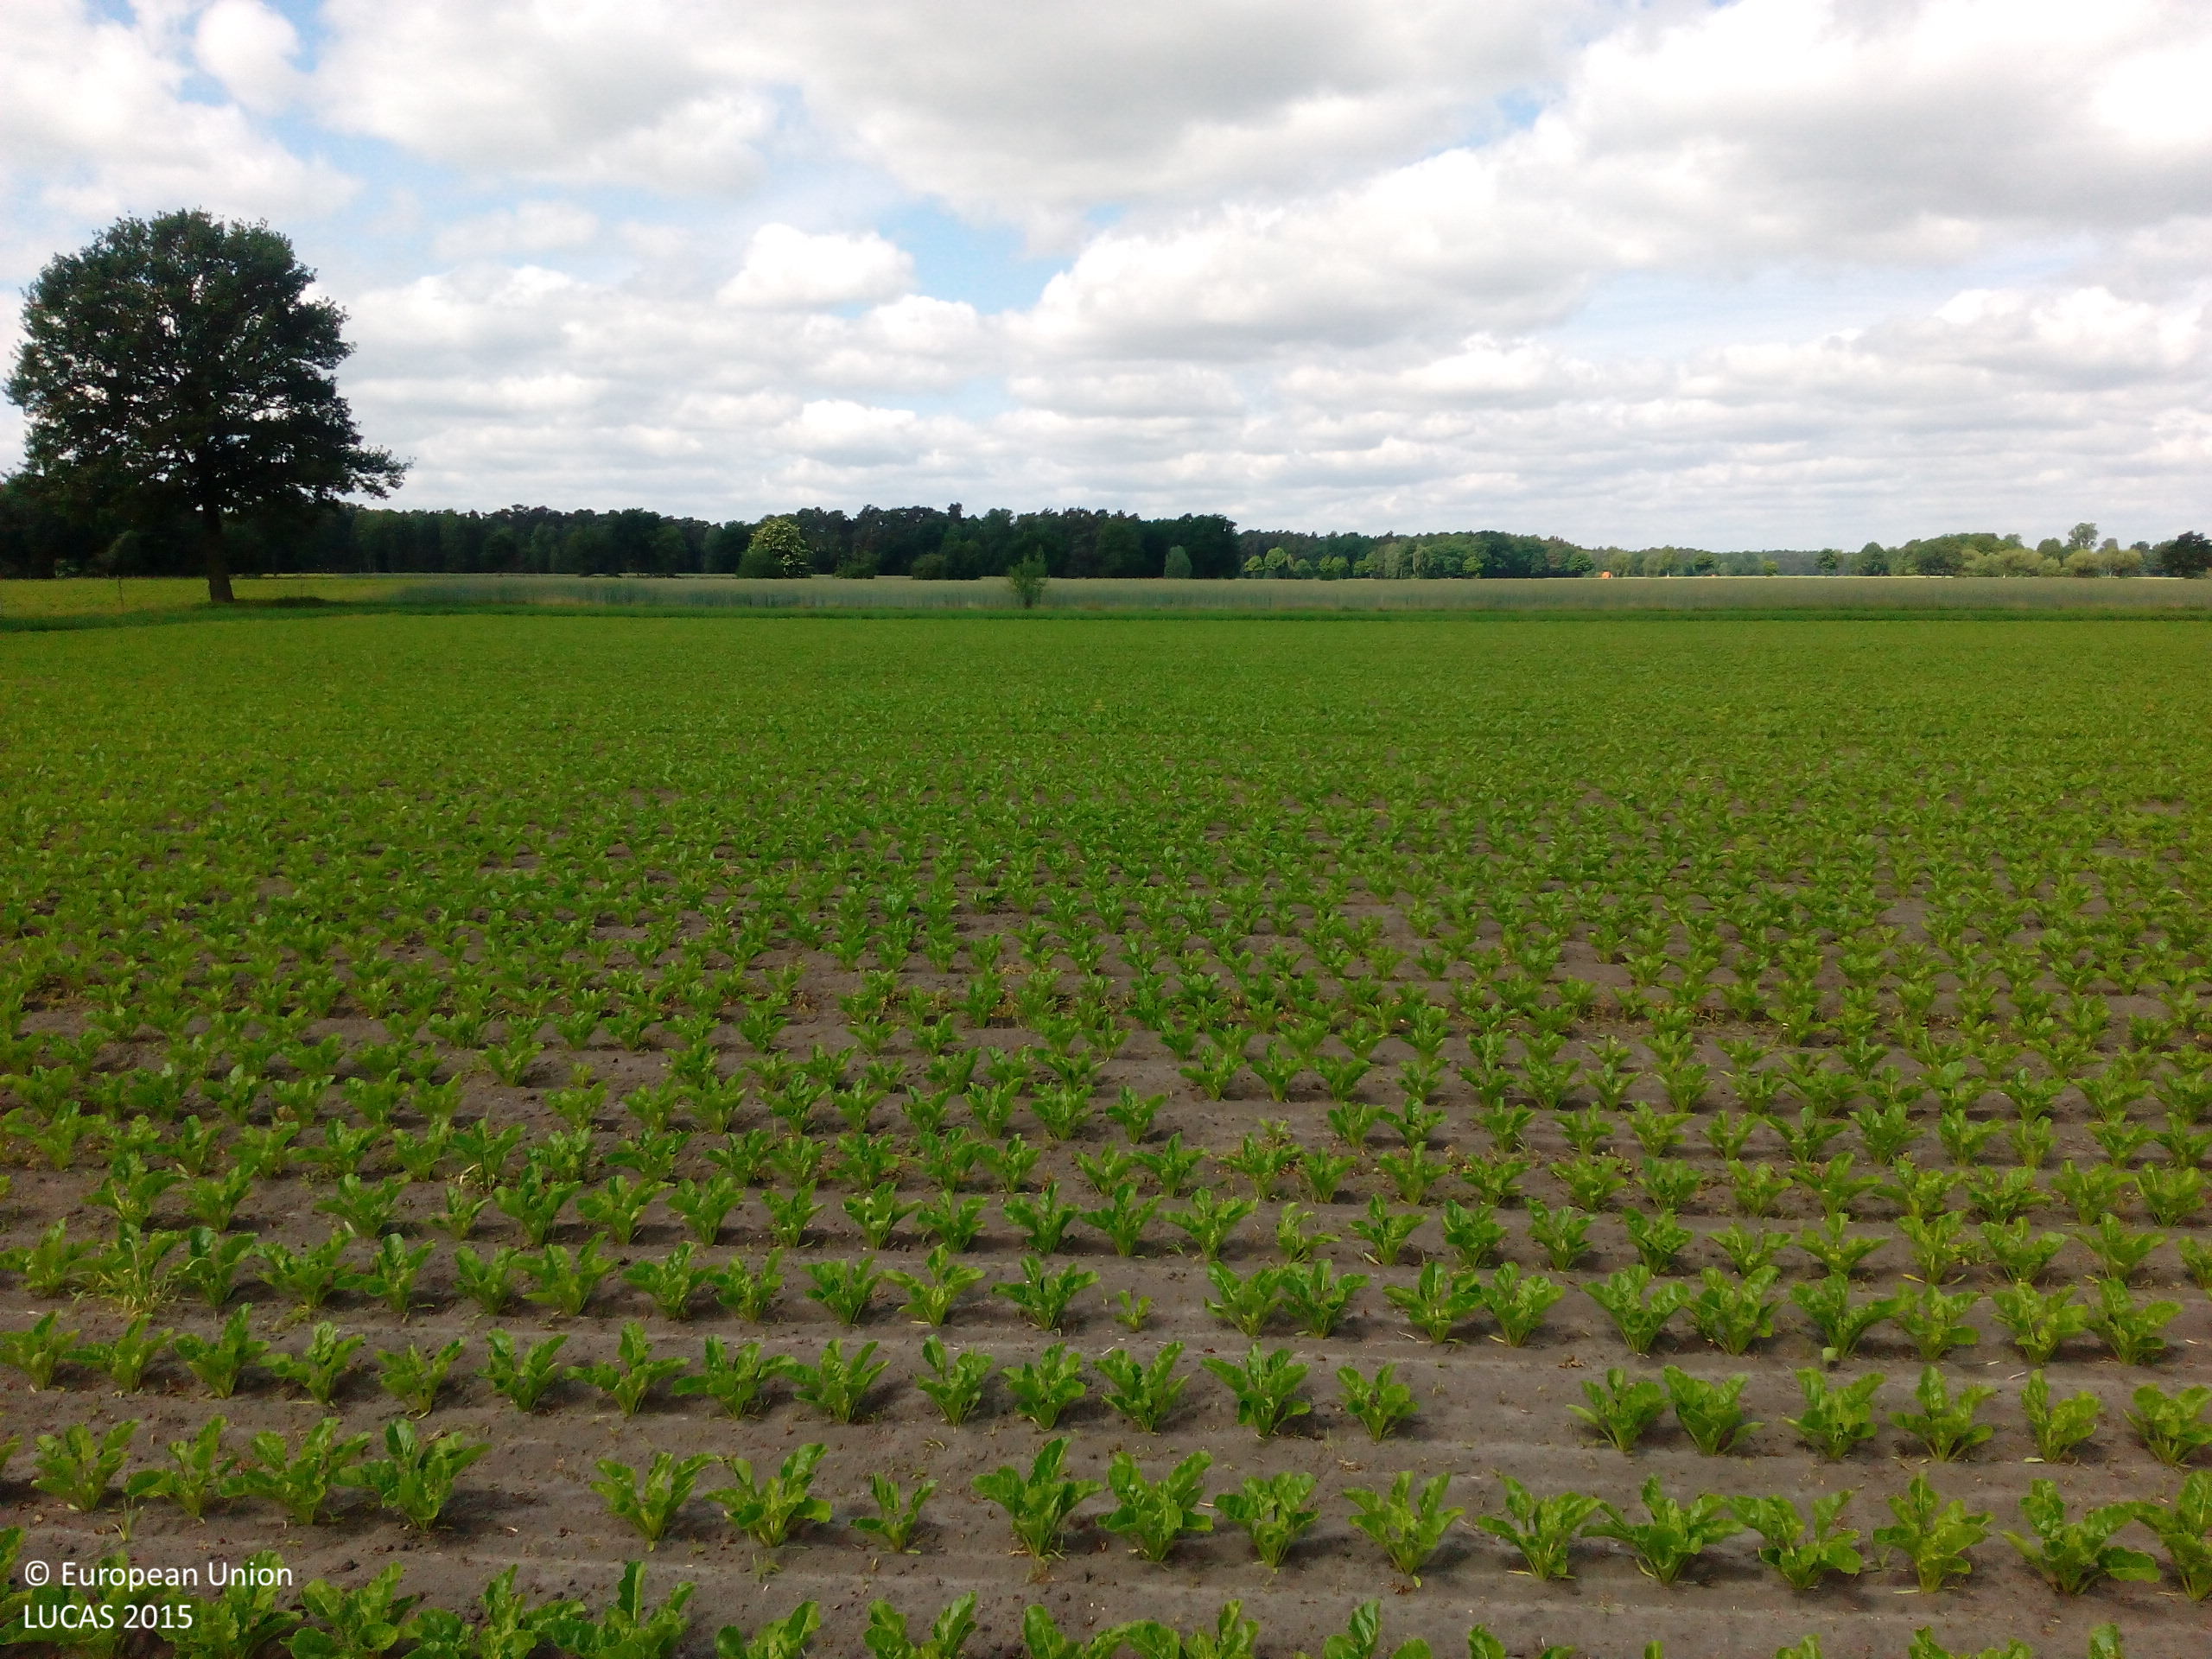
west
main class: Cropland
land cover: Sugar beet
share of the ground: < 10 %
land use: Agriculture (excluding fallow land and kitchen gardens)
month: June
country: DE
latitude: 52.5389
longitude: 10.2800
